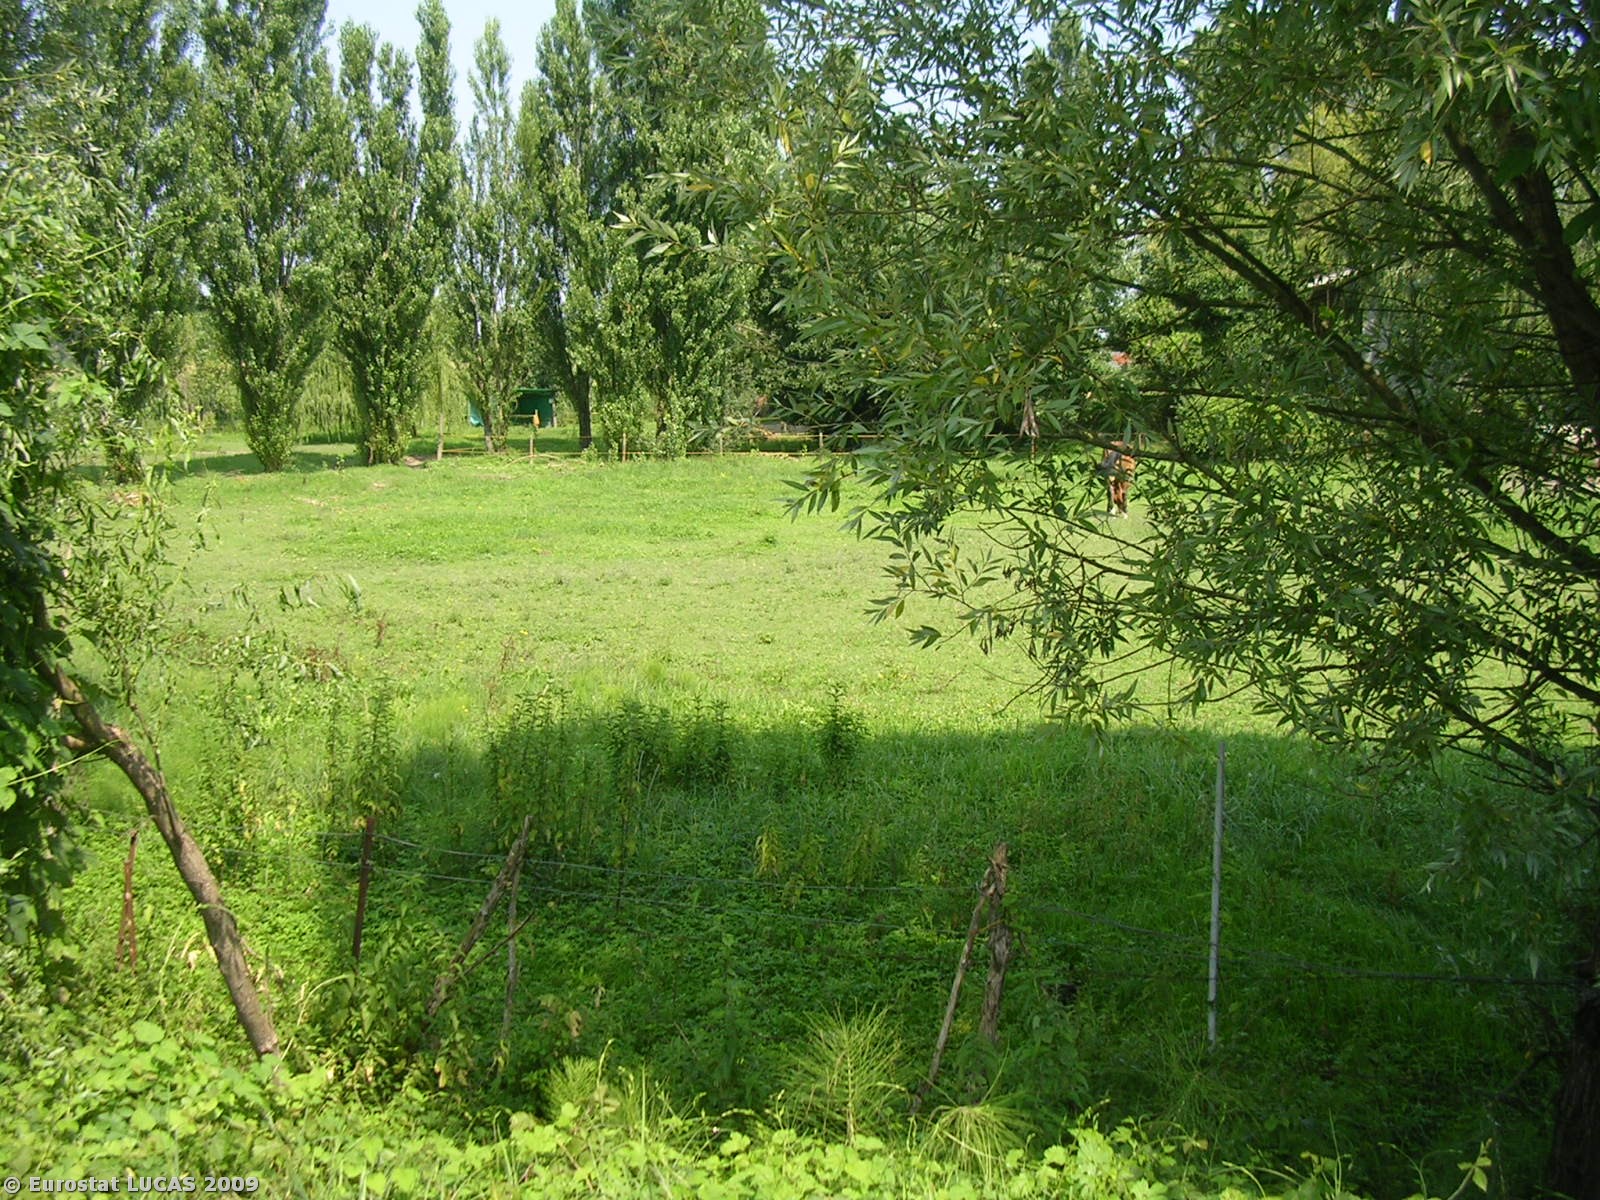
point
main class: Grassland
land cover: Grassland without tree/shrub cover
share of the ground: > 75 %
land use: Agriculture (excluding fallow land and kitchen gardens)
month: July
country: IT
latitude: 45.4899
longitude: 11.7501
